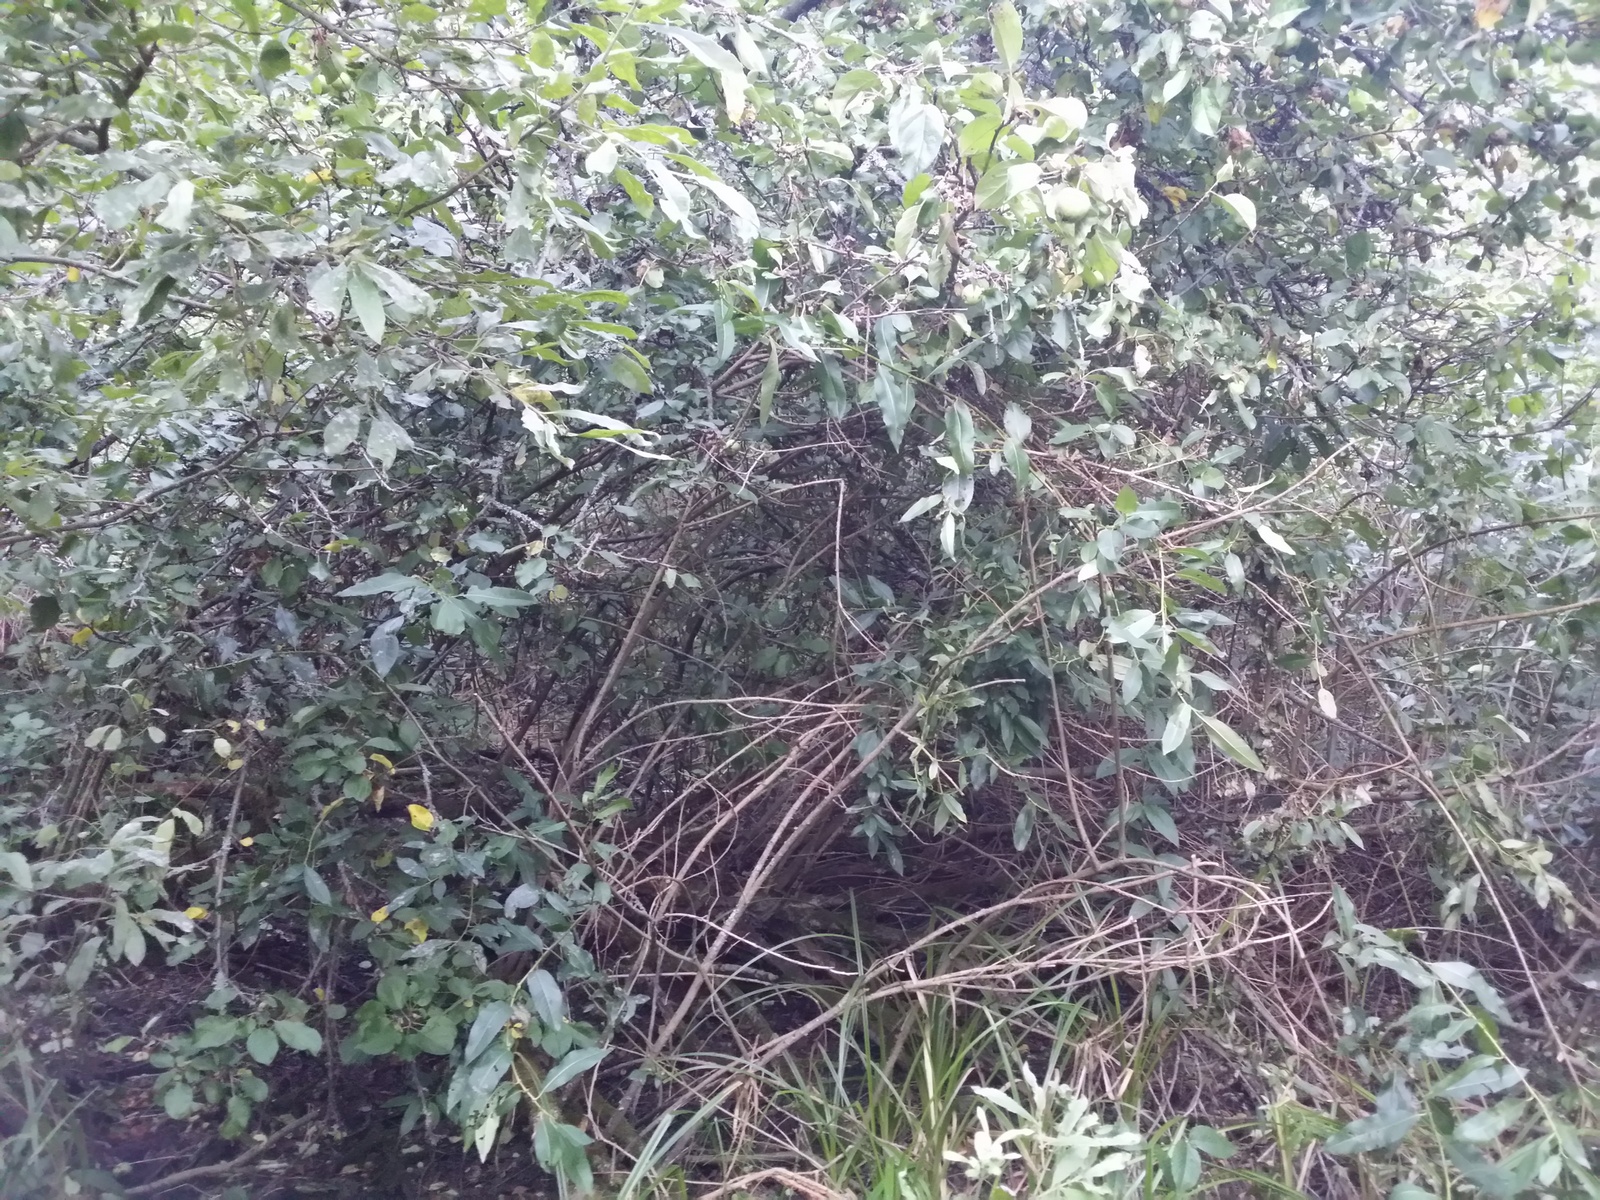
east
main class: Woodland
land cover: Broadleaved woodland
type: non-riverine alder, birch or aspen forest
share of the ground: > 75 %
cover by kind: broadleaved forest trees 90 %, shrubs 5 %, herbaceous plants 5 %
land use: Forestry
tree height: > 5 m
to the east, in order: Broadleaved woodland; Shrubland with sparse tree cover; Broadleaved woodland
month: August
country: LV
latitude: 56.9215
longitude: 27.5431
